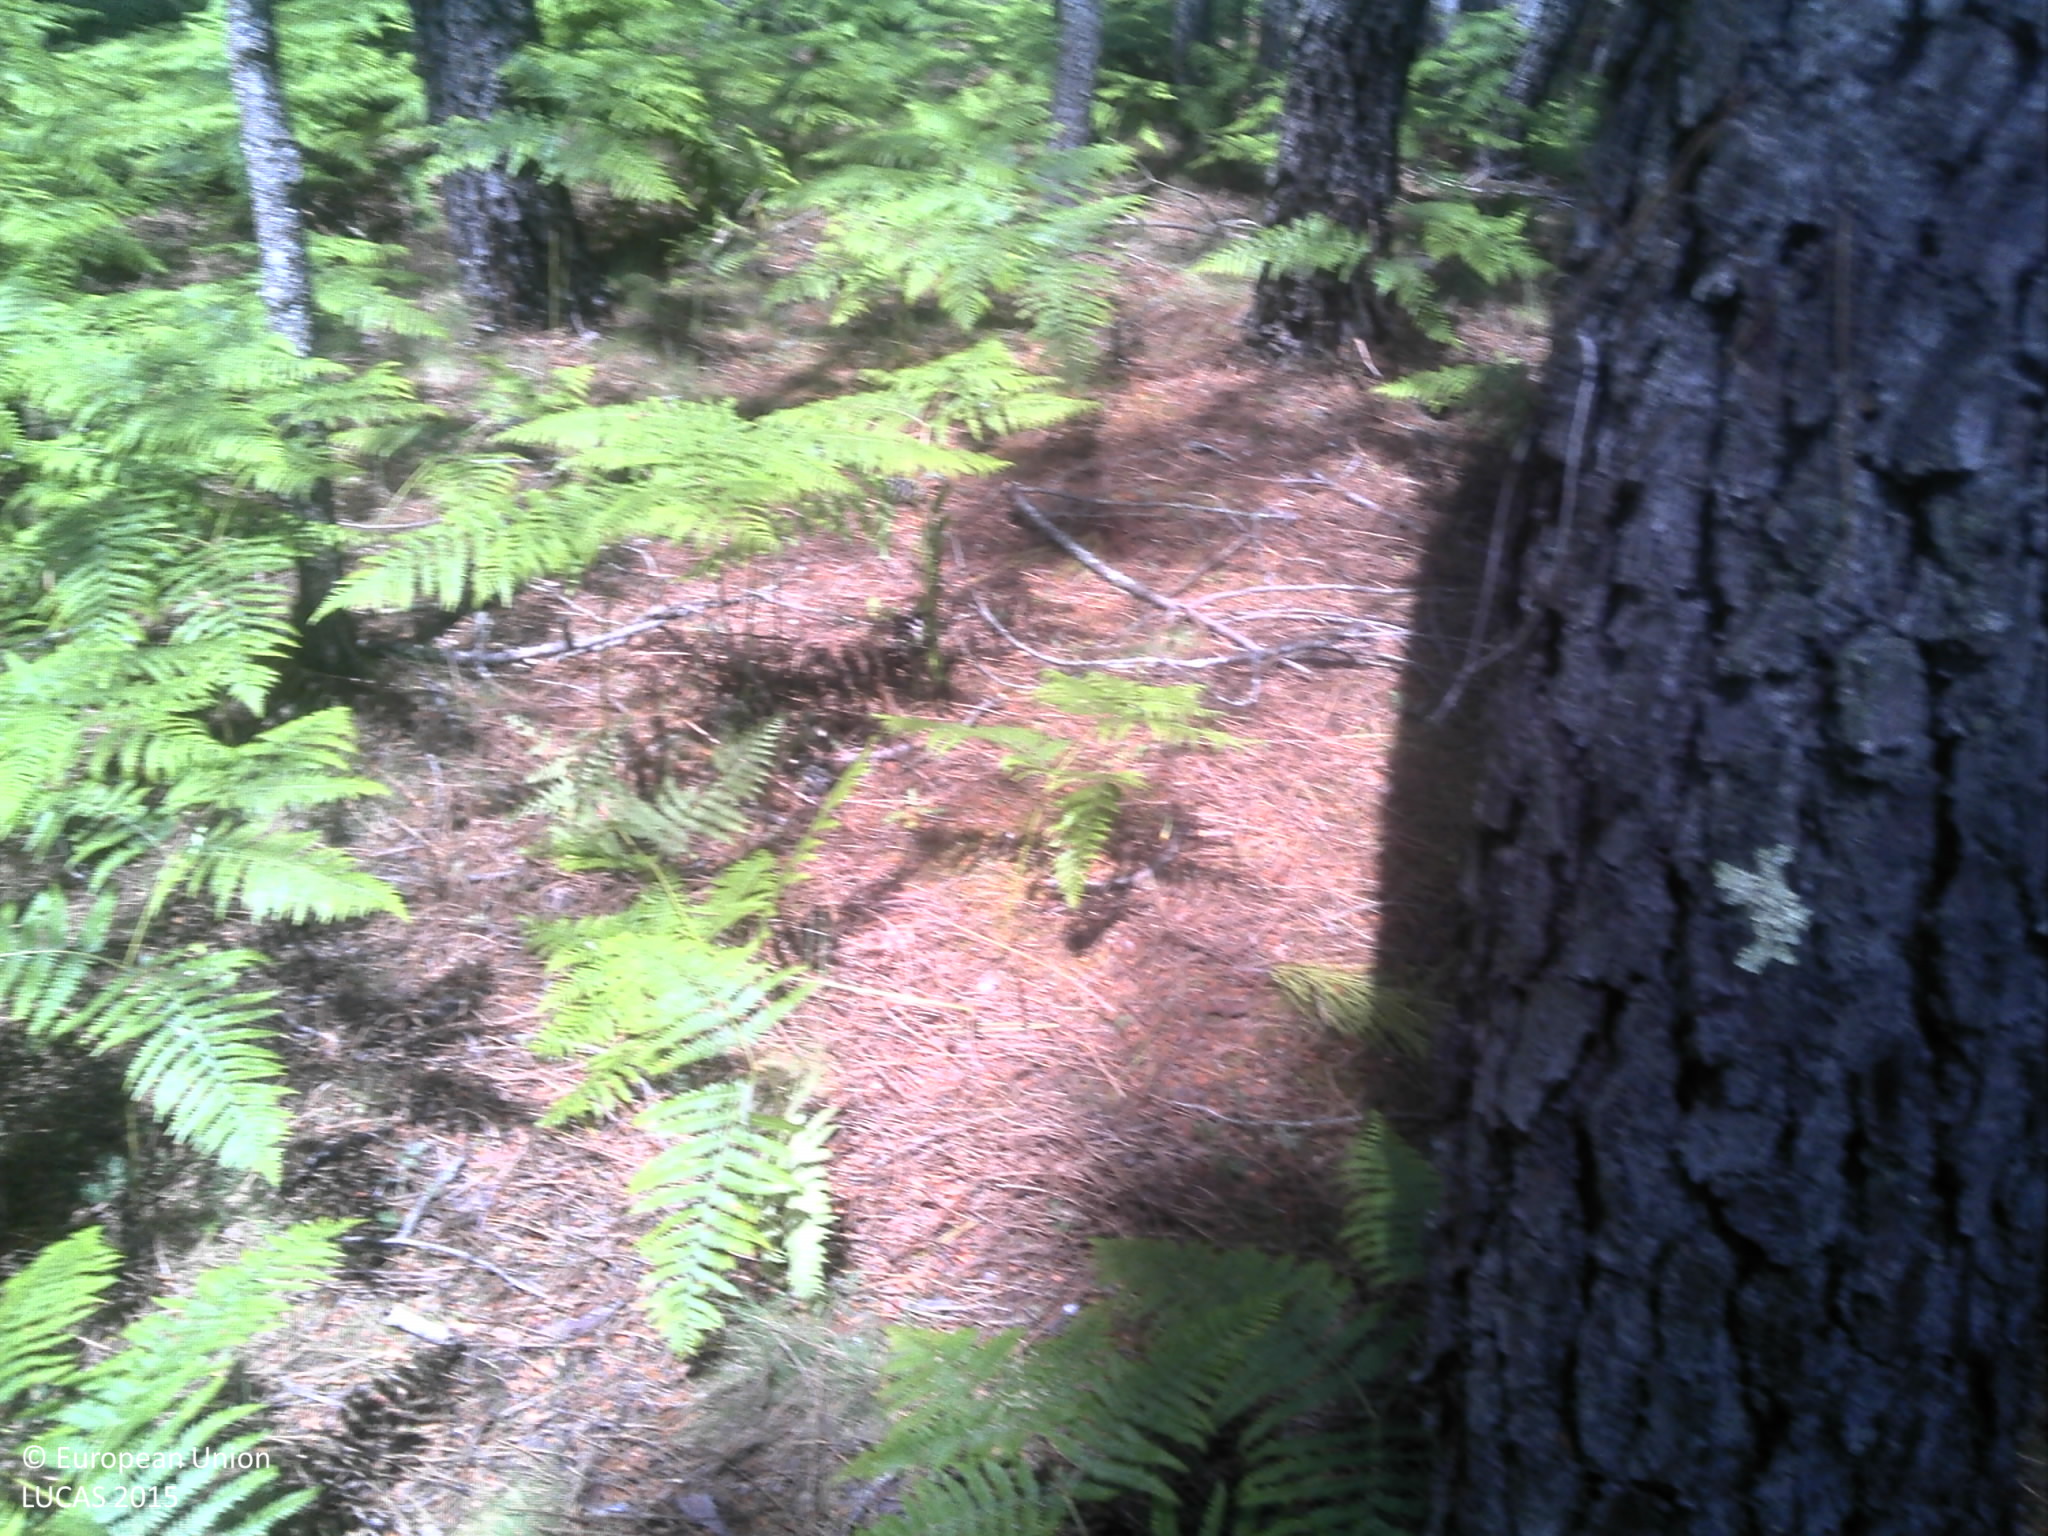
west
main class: Woodland
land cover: Pine dominated coniferous woodland
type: coniferous forest of the mediterranean region
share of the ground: > 75 %
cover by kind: coniferous forest trees 90 %, shrubs 10 %
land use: Forestry
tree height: > 5 m
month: May
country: PT
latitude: 40.6907
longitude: -7.8132
